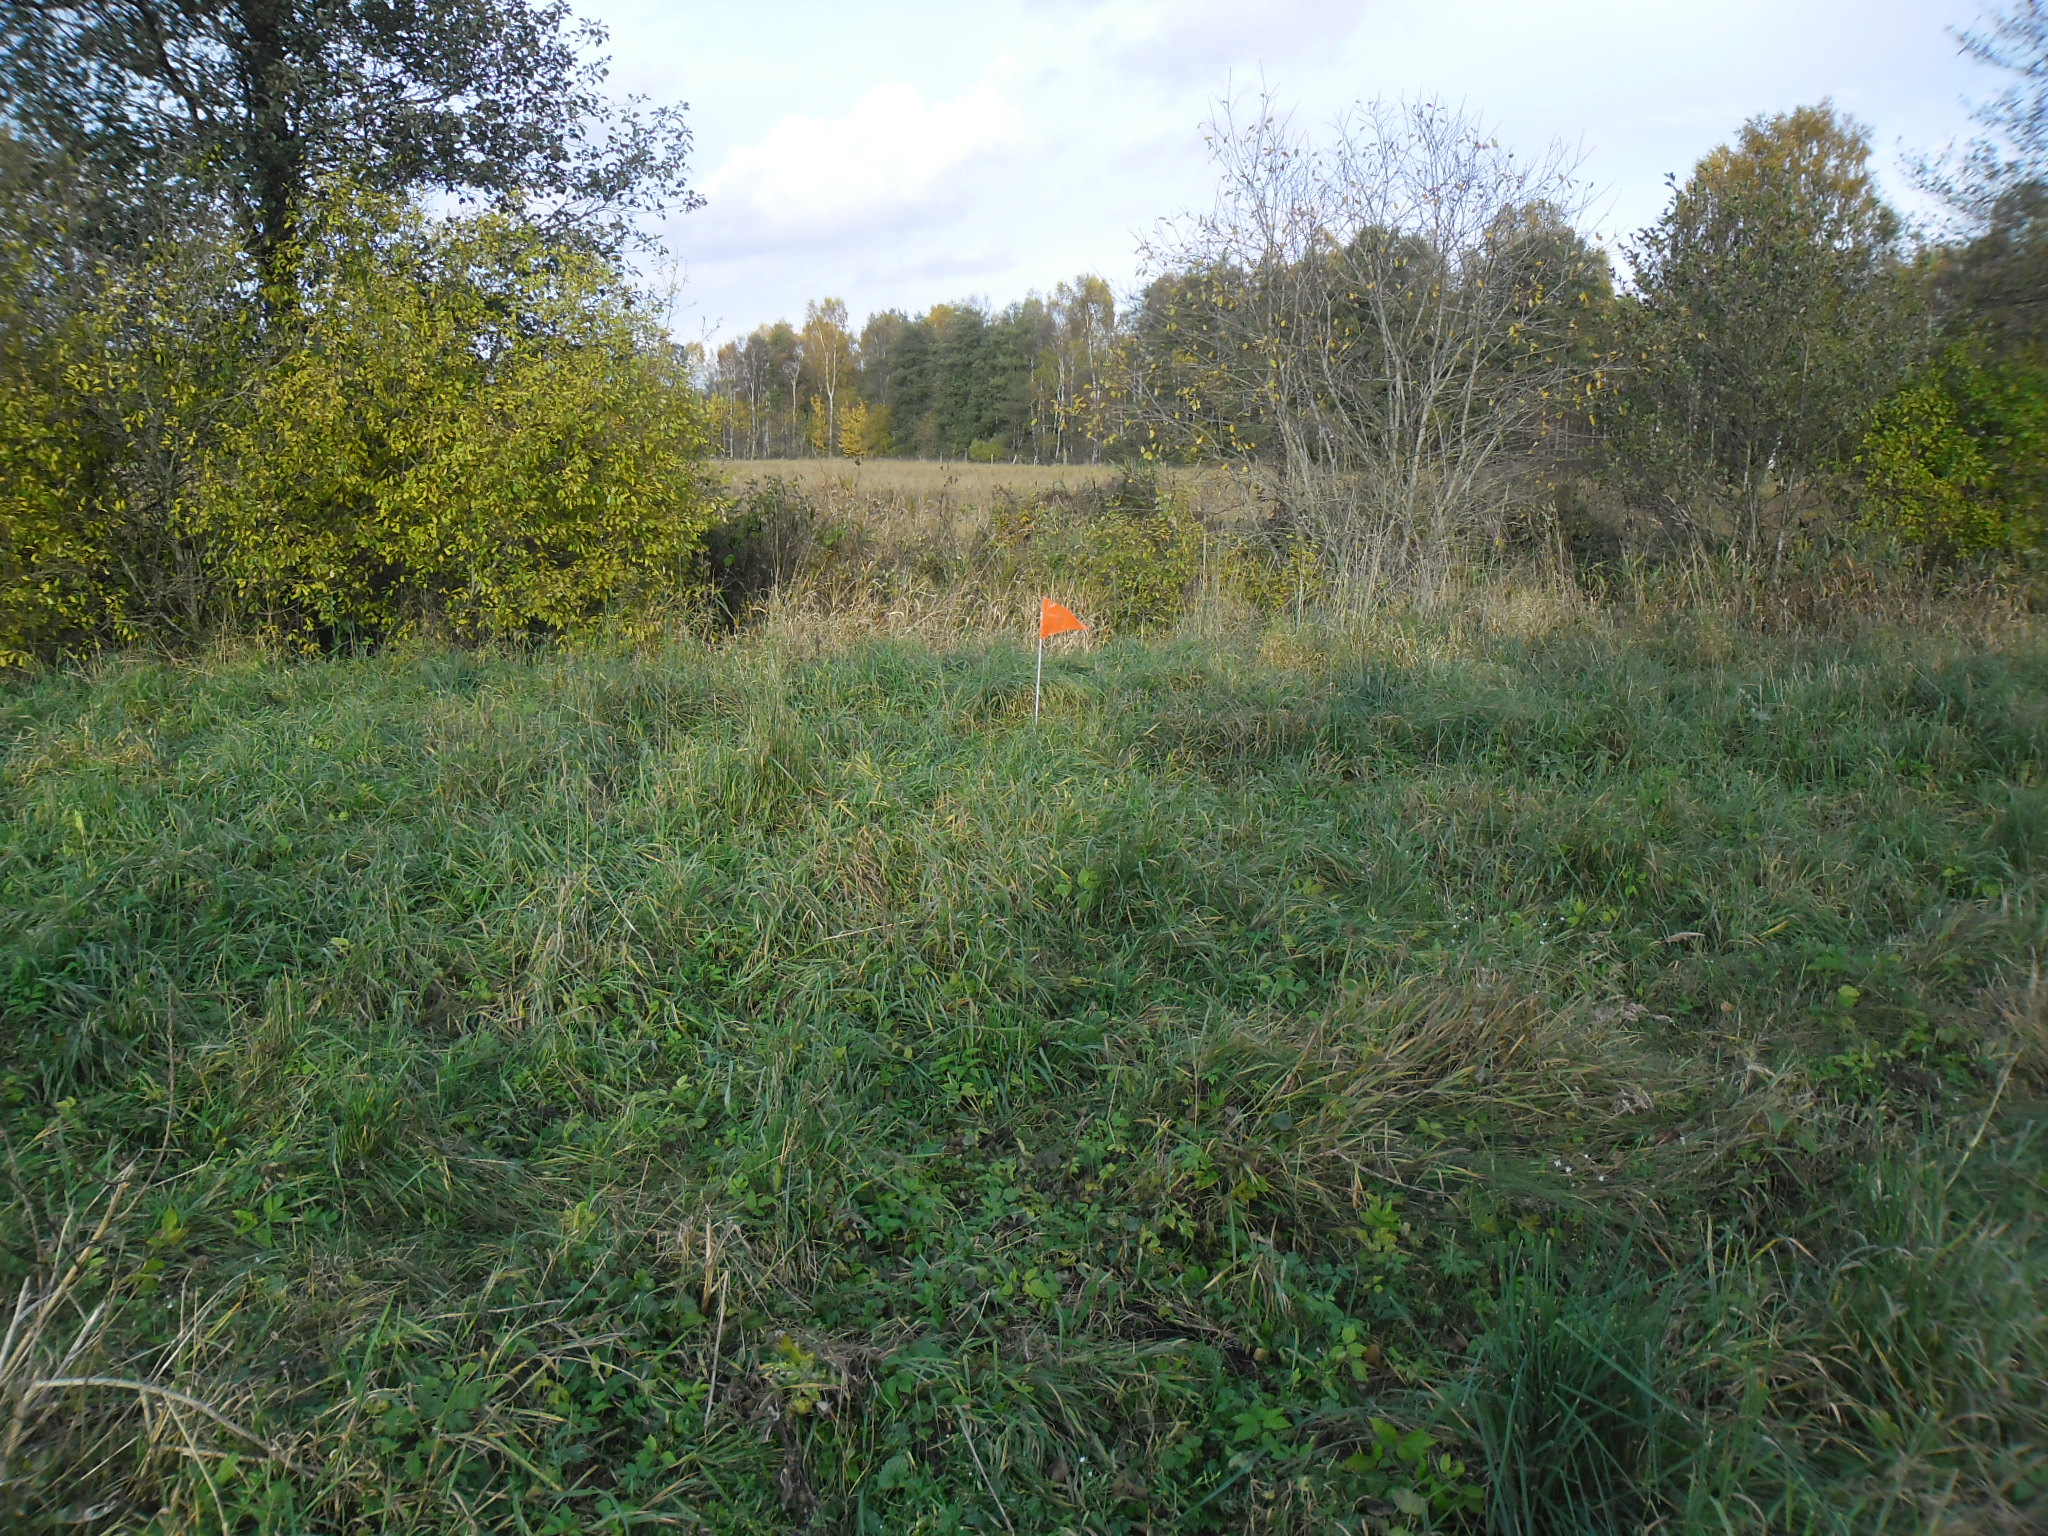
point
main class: Grassland
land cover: Grassland without tree/shrub cover
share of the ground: > 75 %
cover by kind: herbaceous plants 100 %
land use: Agriculture (excluding fallow land and kitchen gardens)
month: October
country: SE
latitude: 56.0613
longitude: 13.7397
